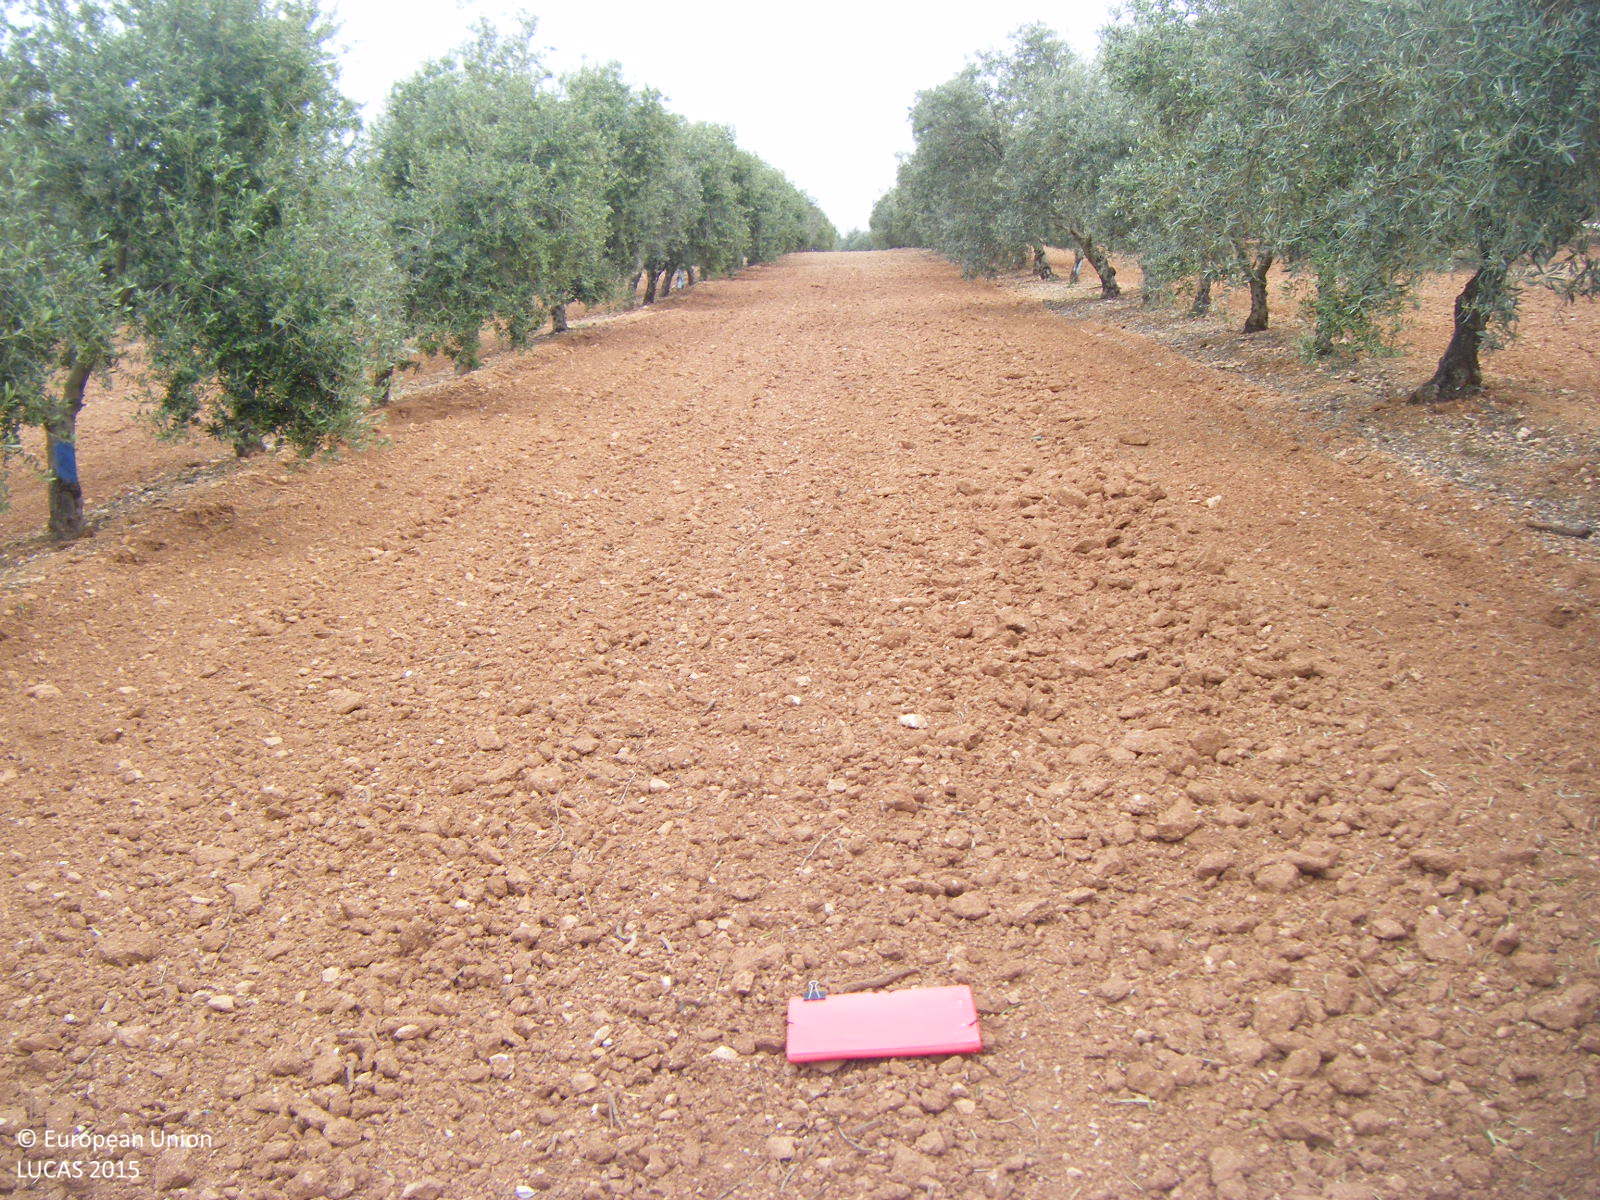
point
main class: Cropland
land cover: Olive groves
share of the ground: 25 - 50 %
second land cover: Other bare soil
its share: > 75 %
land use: Agriculture (excluding fallow land and kitchen gardens)
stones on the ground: < 10 %
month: April
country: ES
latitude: 37.1907
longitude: -4.7938
